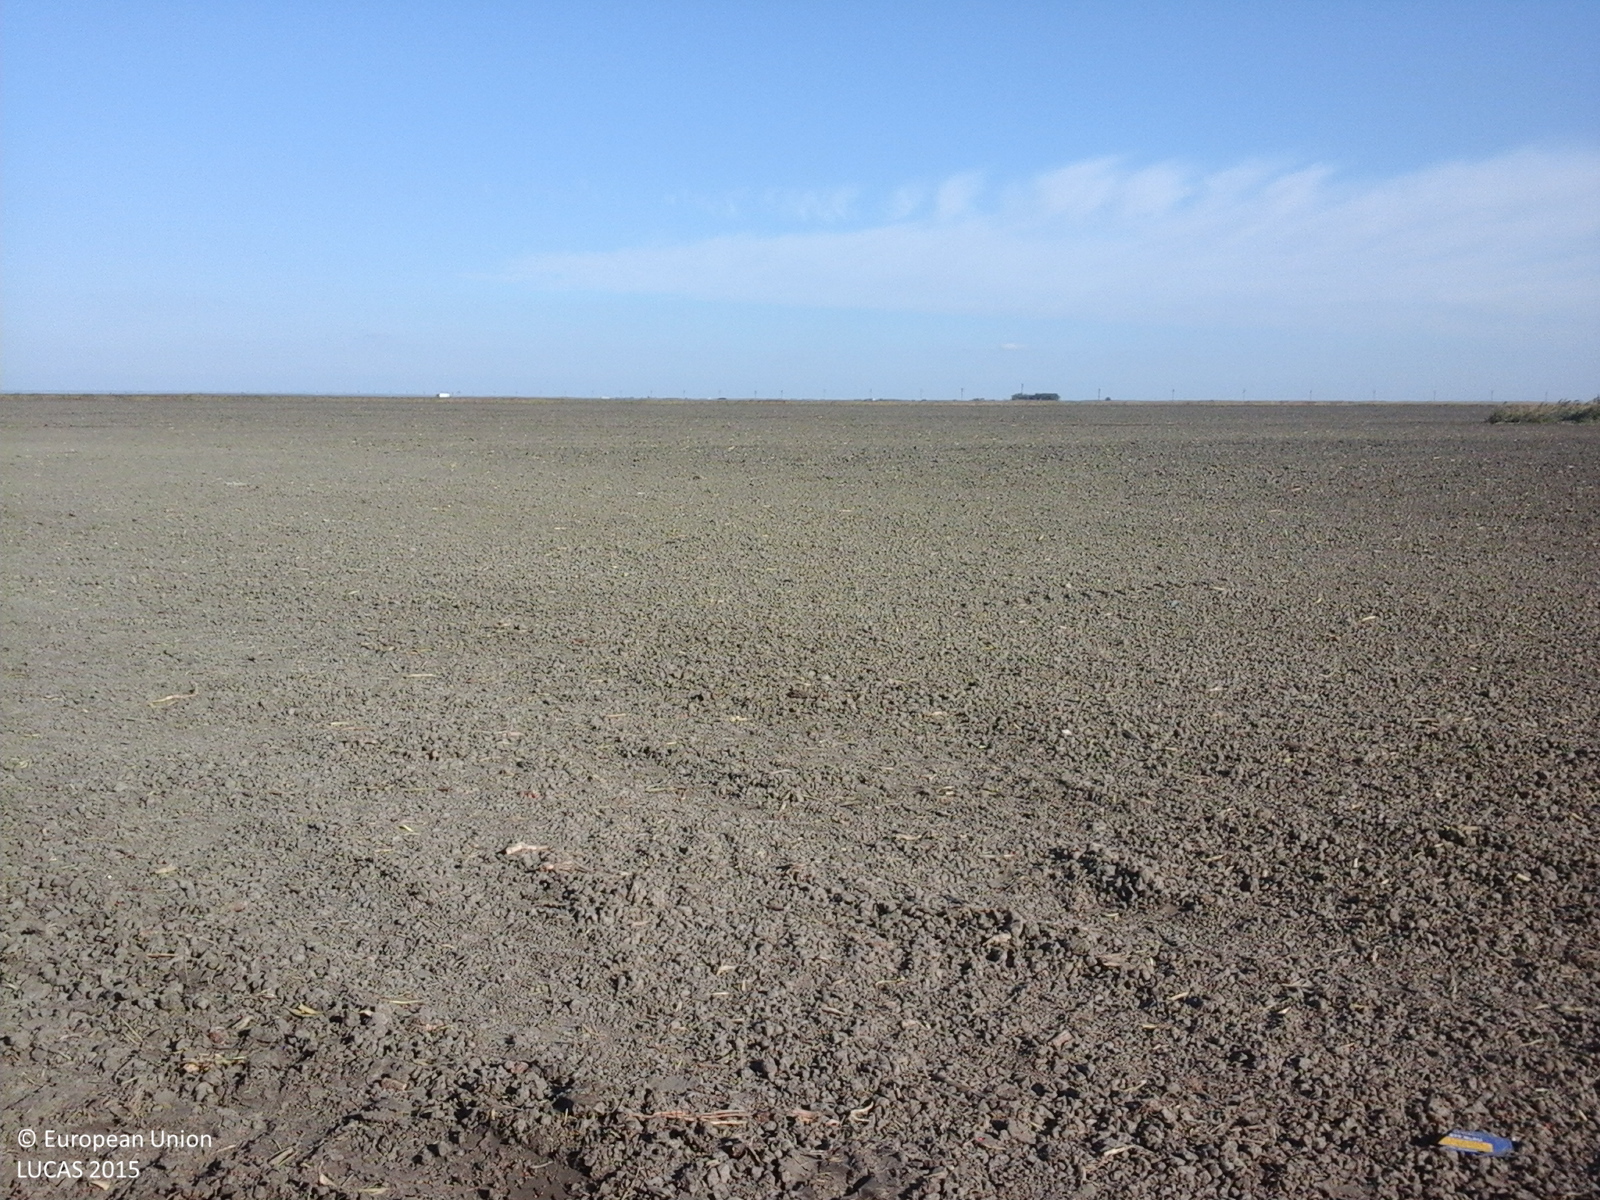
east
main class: Cropland
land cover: Common wheat
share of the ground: > 75 %
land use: Agriculture (excluding fallow land and kitchen gardens)
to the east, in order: Common wheat; Spontaneously vegetated surfaces; Ditches and canals; Spontaneously vegetated surfaces; Common wheat
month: October
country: RO
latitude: 45.4194
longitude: 27.4415
